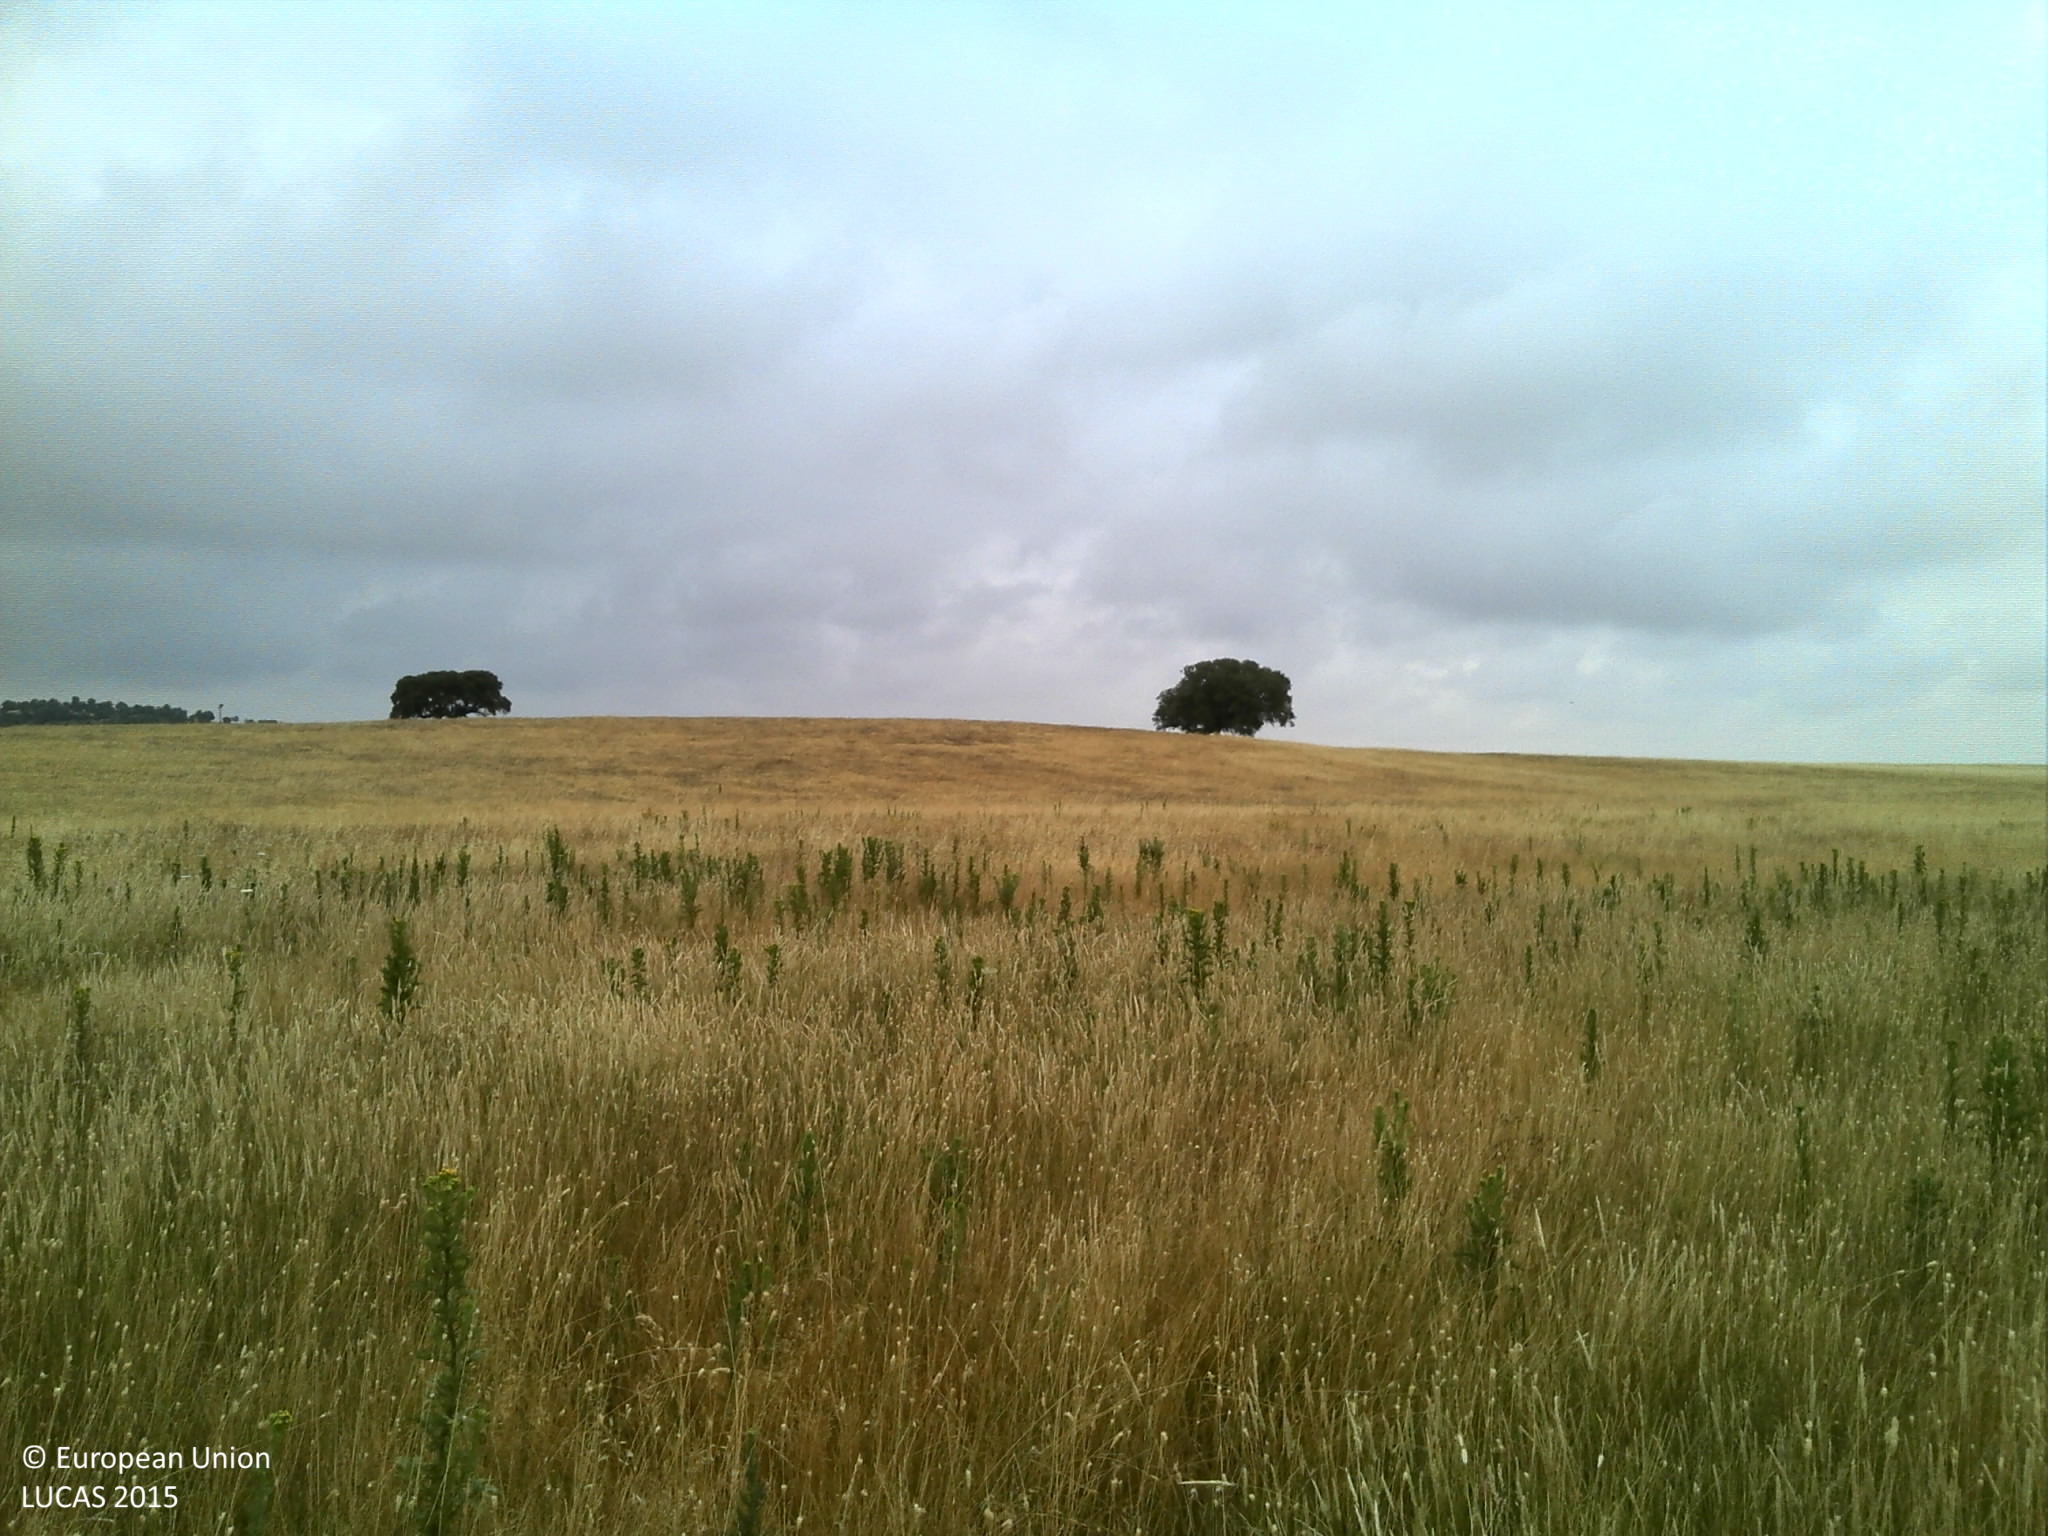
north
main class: Grassland
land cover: Grassland without tree/shrub cover
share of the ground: > 75 %
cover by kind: herbaceous plants 90 %, unconsolidated bare surface 10 %
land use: Agriculture (excluding fallow land and kitchen gardens)
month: June
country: PT
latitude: 38.3702
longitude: -7.9728
